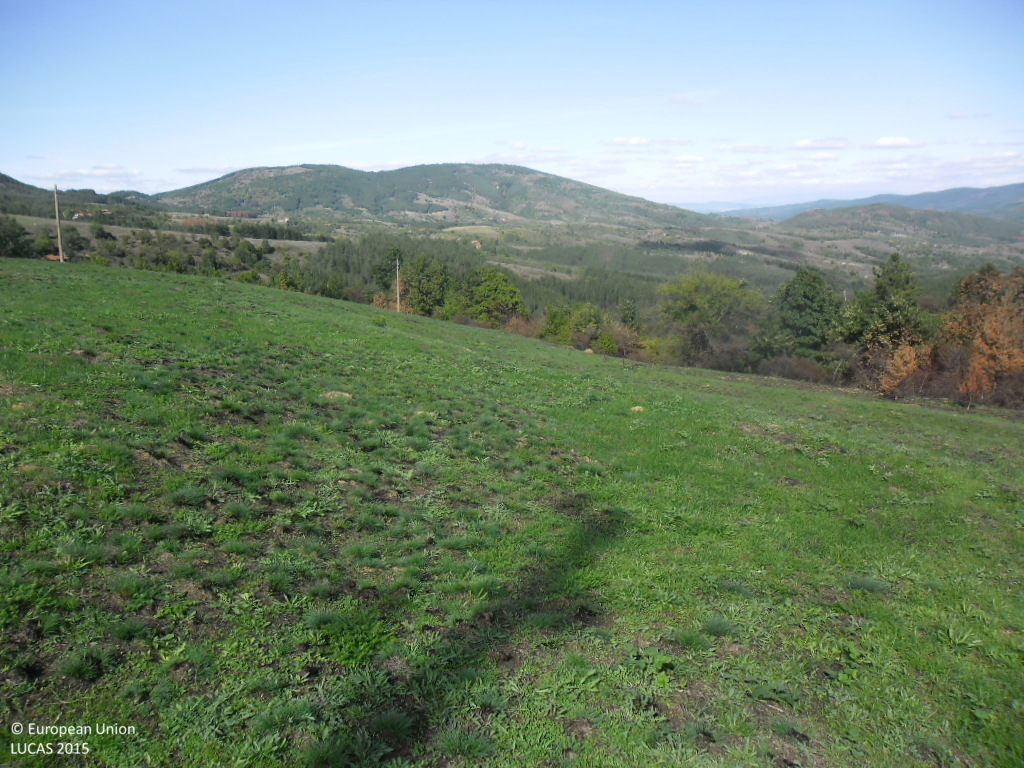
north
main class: Grassland
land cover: Grassland without tree/shrub cover
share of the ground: > 75 %
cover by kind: herbaceous plants 100 %
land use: Agriculture (excluding fallow land and kitchen gardens)
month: October
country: BG
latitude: 42.0760
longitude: 22.7972
